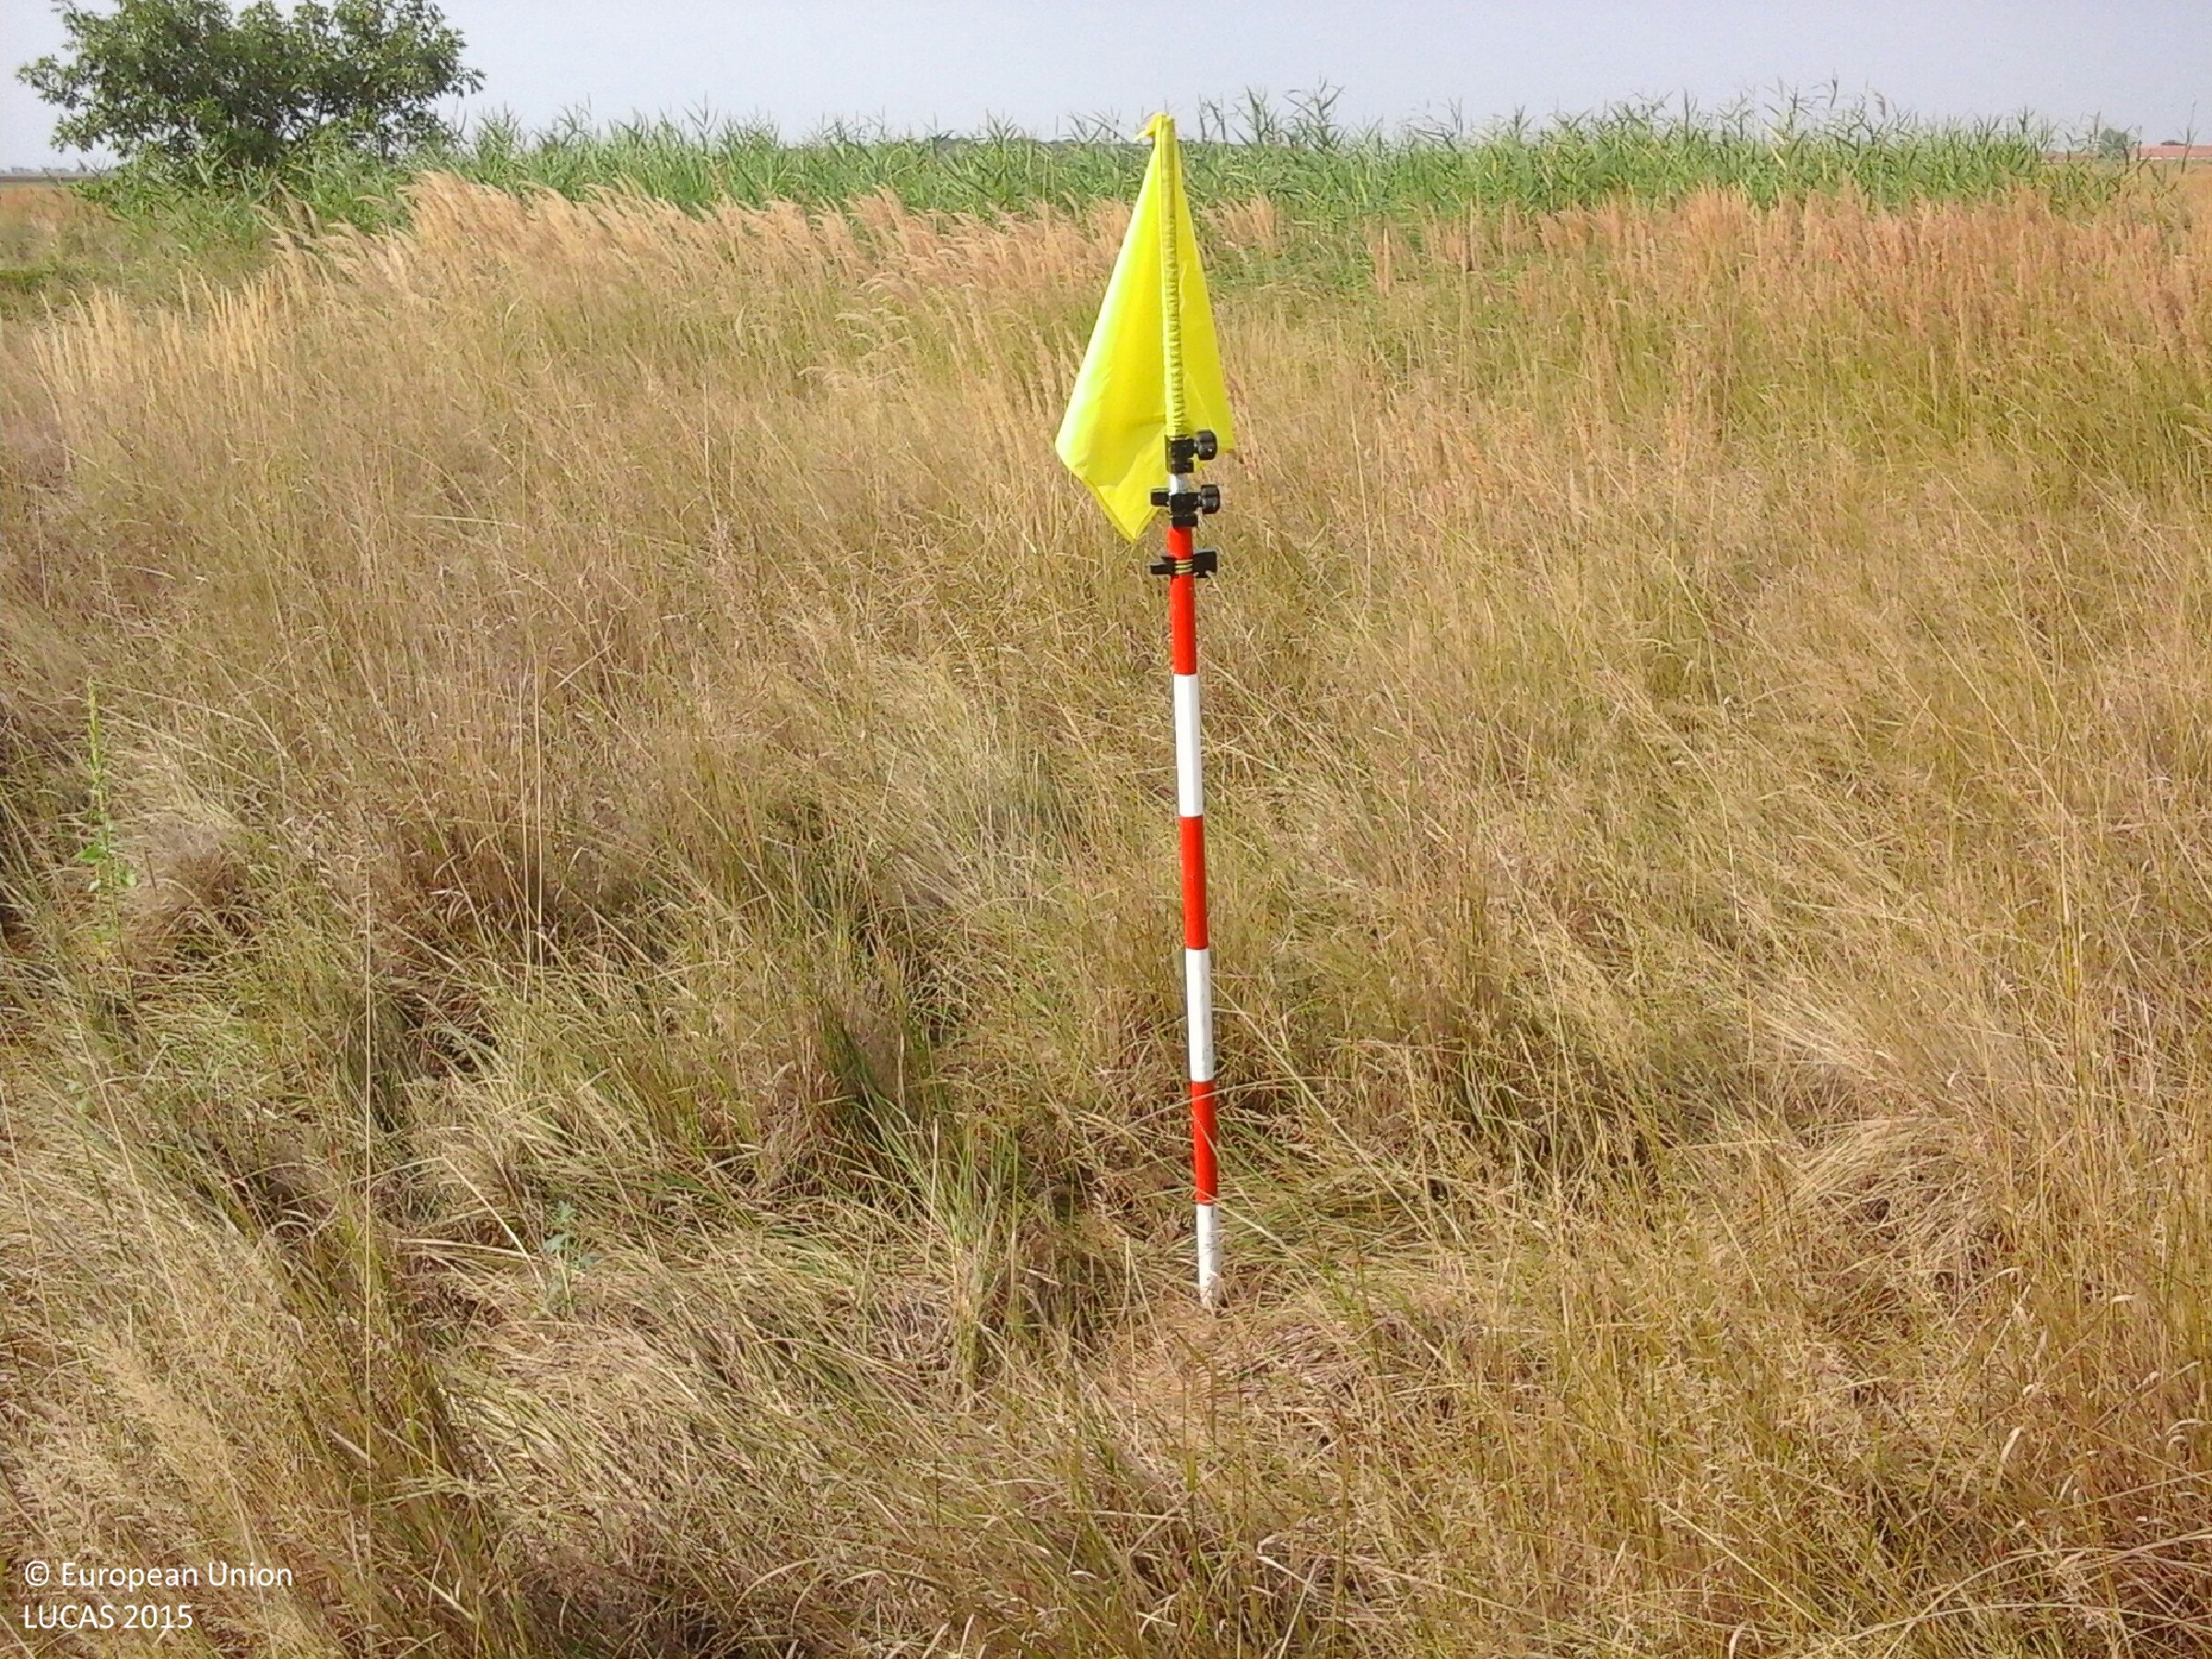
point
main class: Grassland
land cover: Grassland without tree/shrub cover
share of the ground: > 75 %
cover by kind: herbaceous plants 100 %
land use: Agriculture (excluding fallow land and kitchen gardens)
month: August
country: HU
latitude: 47.5497
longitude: 20.9454
